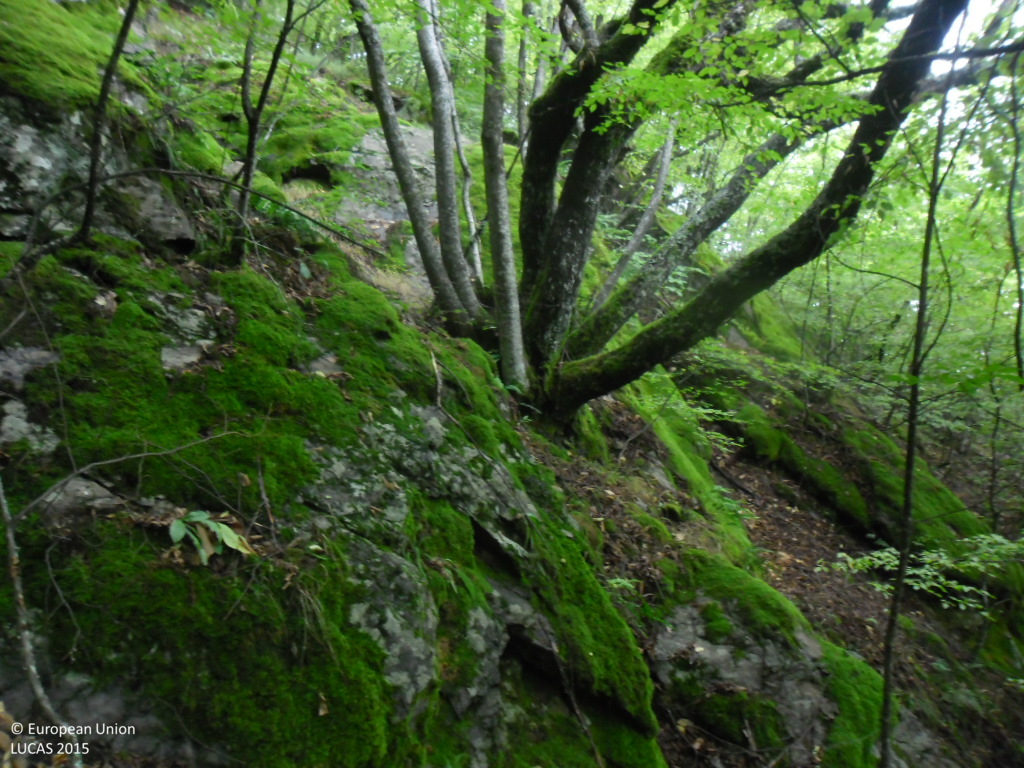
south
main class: Woodland
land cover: Broadleaved woodland
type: mesophytic deciduous forest
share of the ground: > 75 %
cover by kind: broadleaved forest trees 90 %, unconsolidated bare surface 10 %
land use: Forestry
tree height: > 5 m
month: September
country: BG
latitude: 41.3574
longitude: 22.9851
